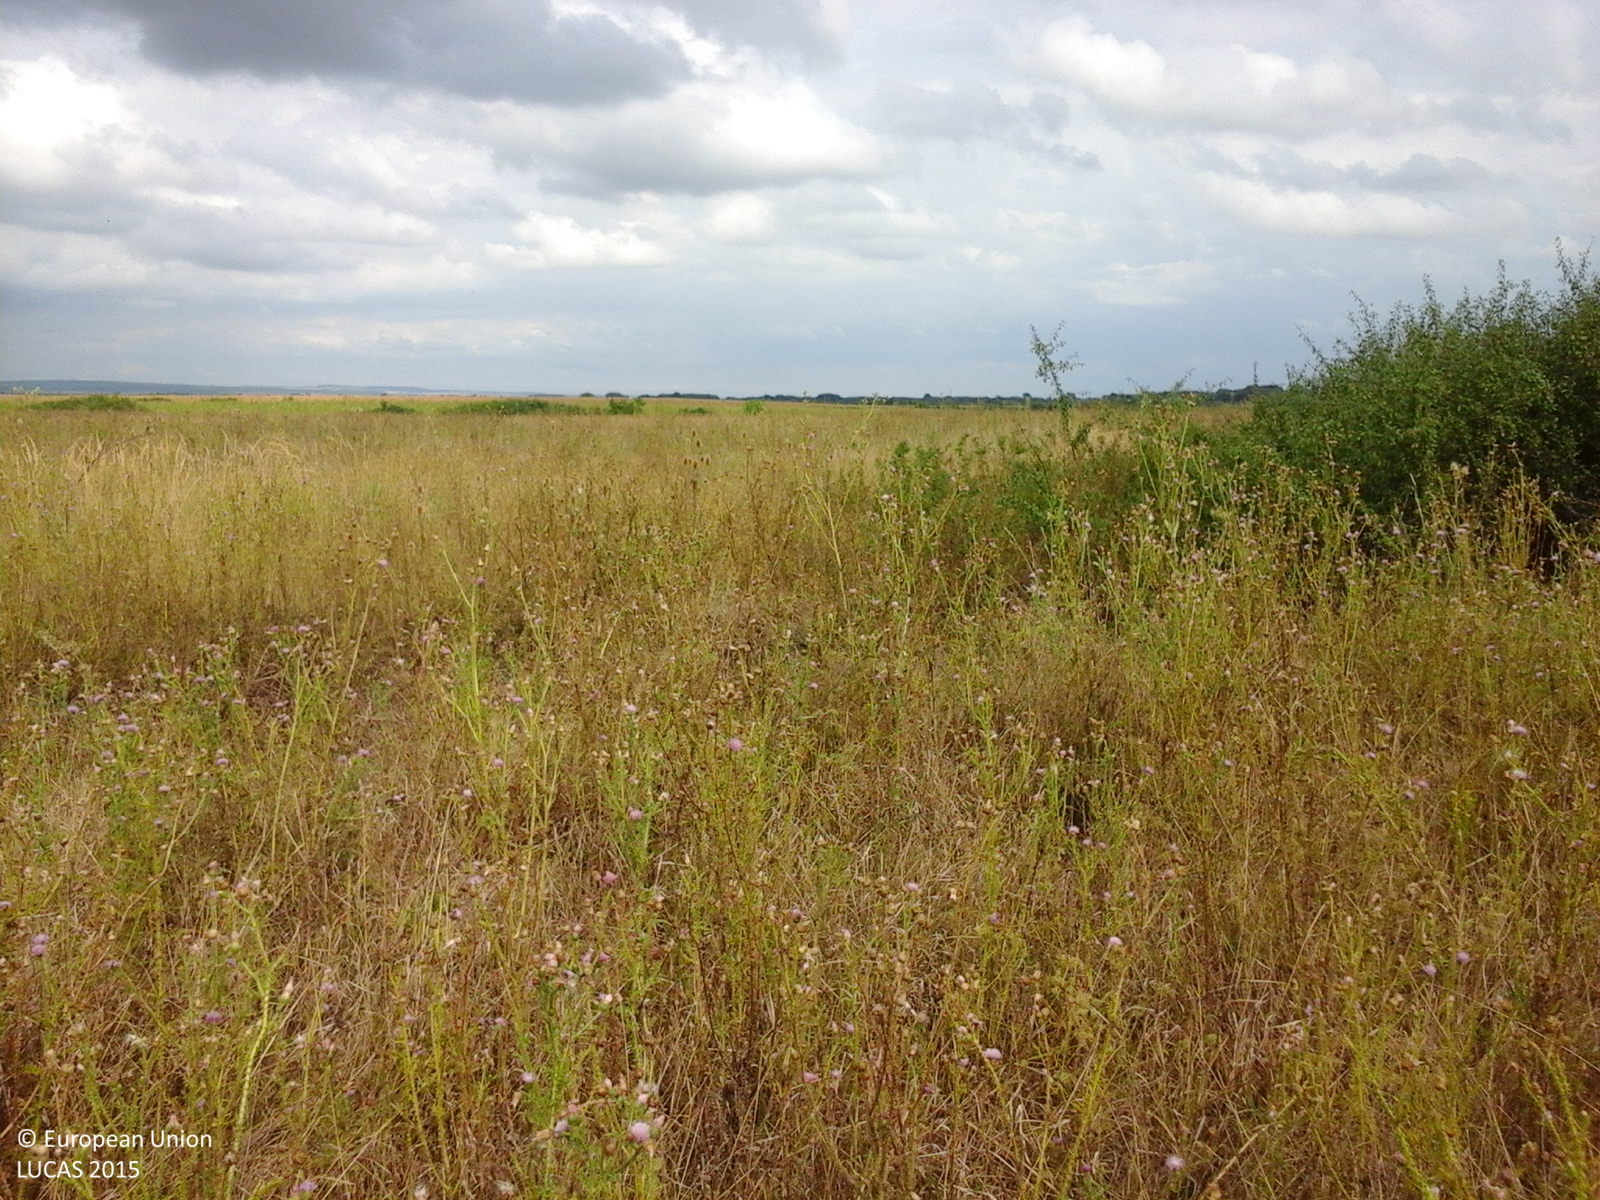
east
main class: Grassland
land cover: Spontaneously vegetated surfaces
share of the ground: > 75 %
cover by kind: herbaceous plants 100 %
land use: Fallow land
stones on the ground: < 10 %
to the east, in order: Spontaneously vegetated surfaces; Ditches and canals; Spontaneously vegetated surfaces; Common wheat; Lucerne; Spontaneously vegetated surfaces; Lines of trees; Ditches and canals; Lines of trees; Grassland without tree/shrub cover
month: August
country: RO
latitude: 45.7772
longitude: 21.3887
